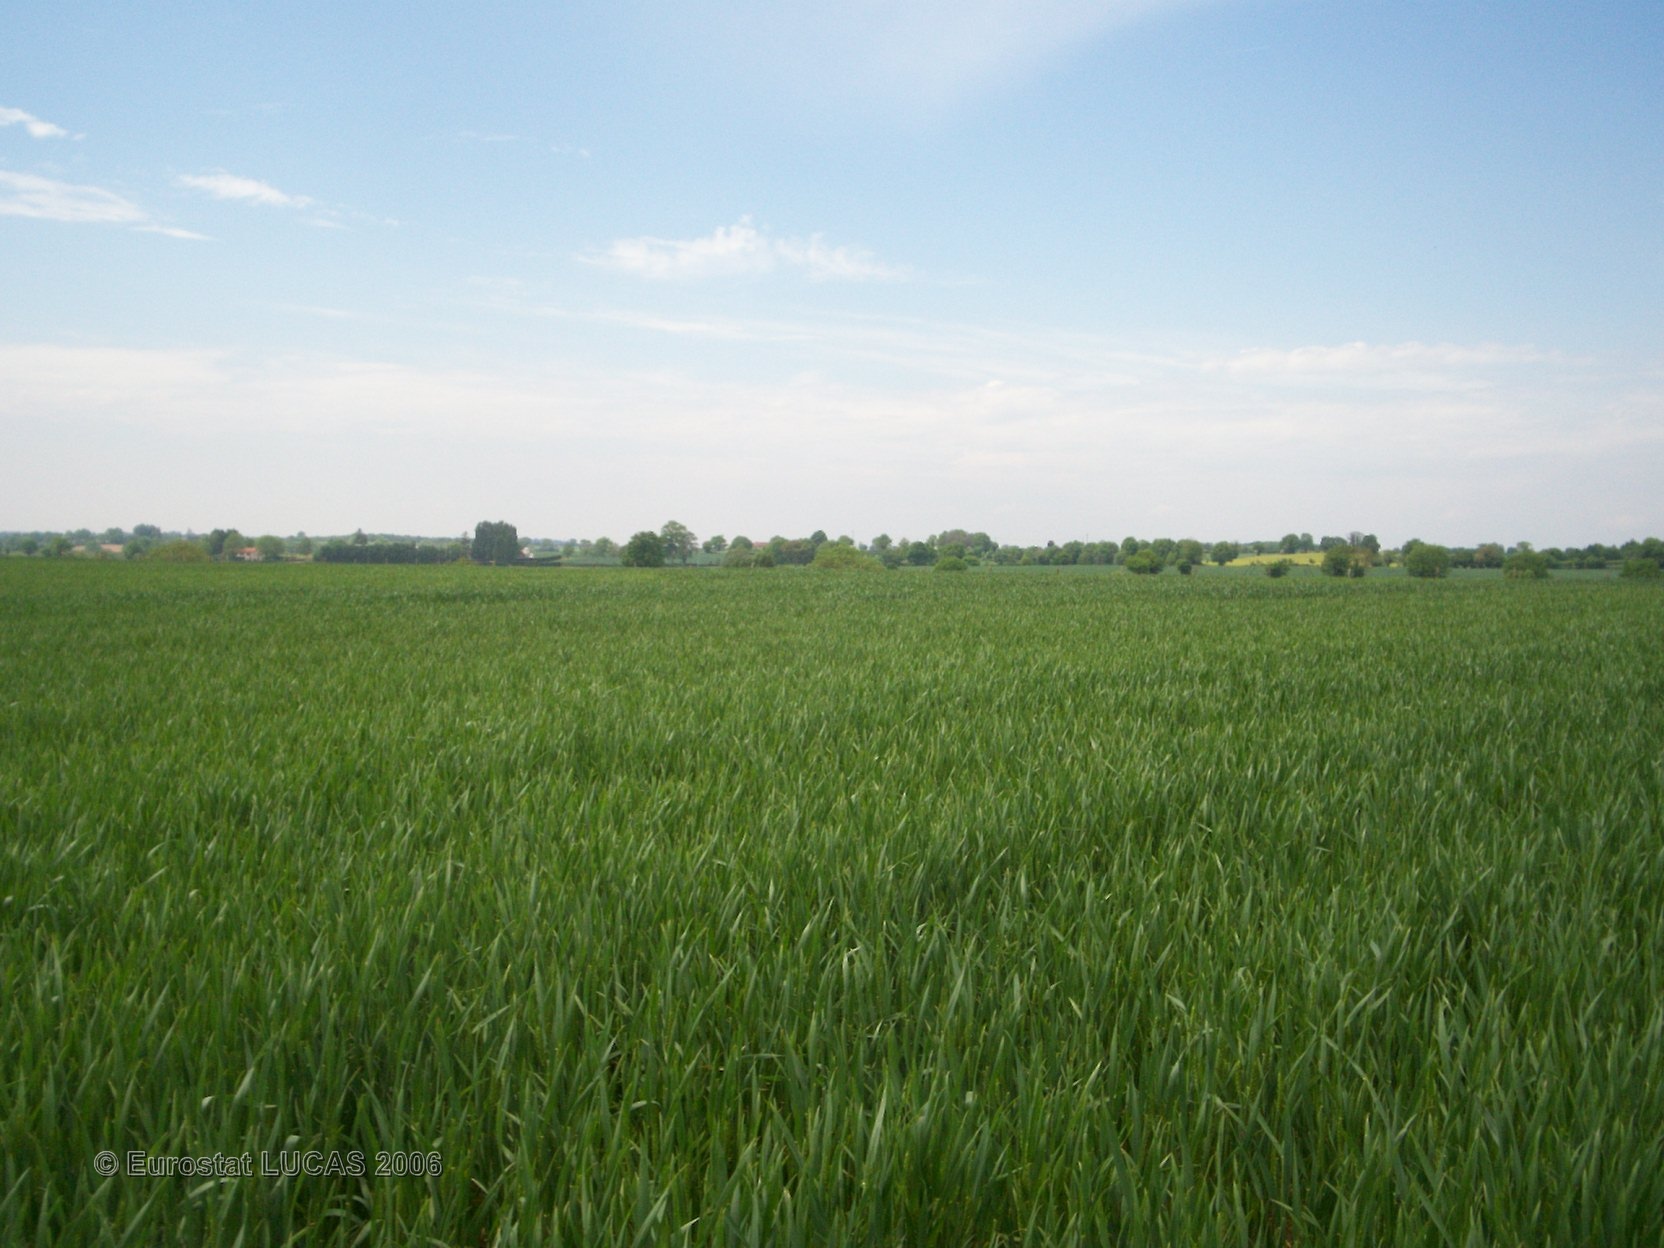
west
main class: Cropland
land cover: Barley
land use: Agriculture (excluding fallow land and kitchen gardens)
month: May
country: FR
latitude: 46.7620
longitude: -0.8332
